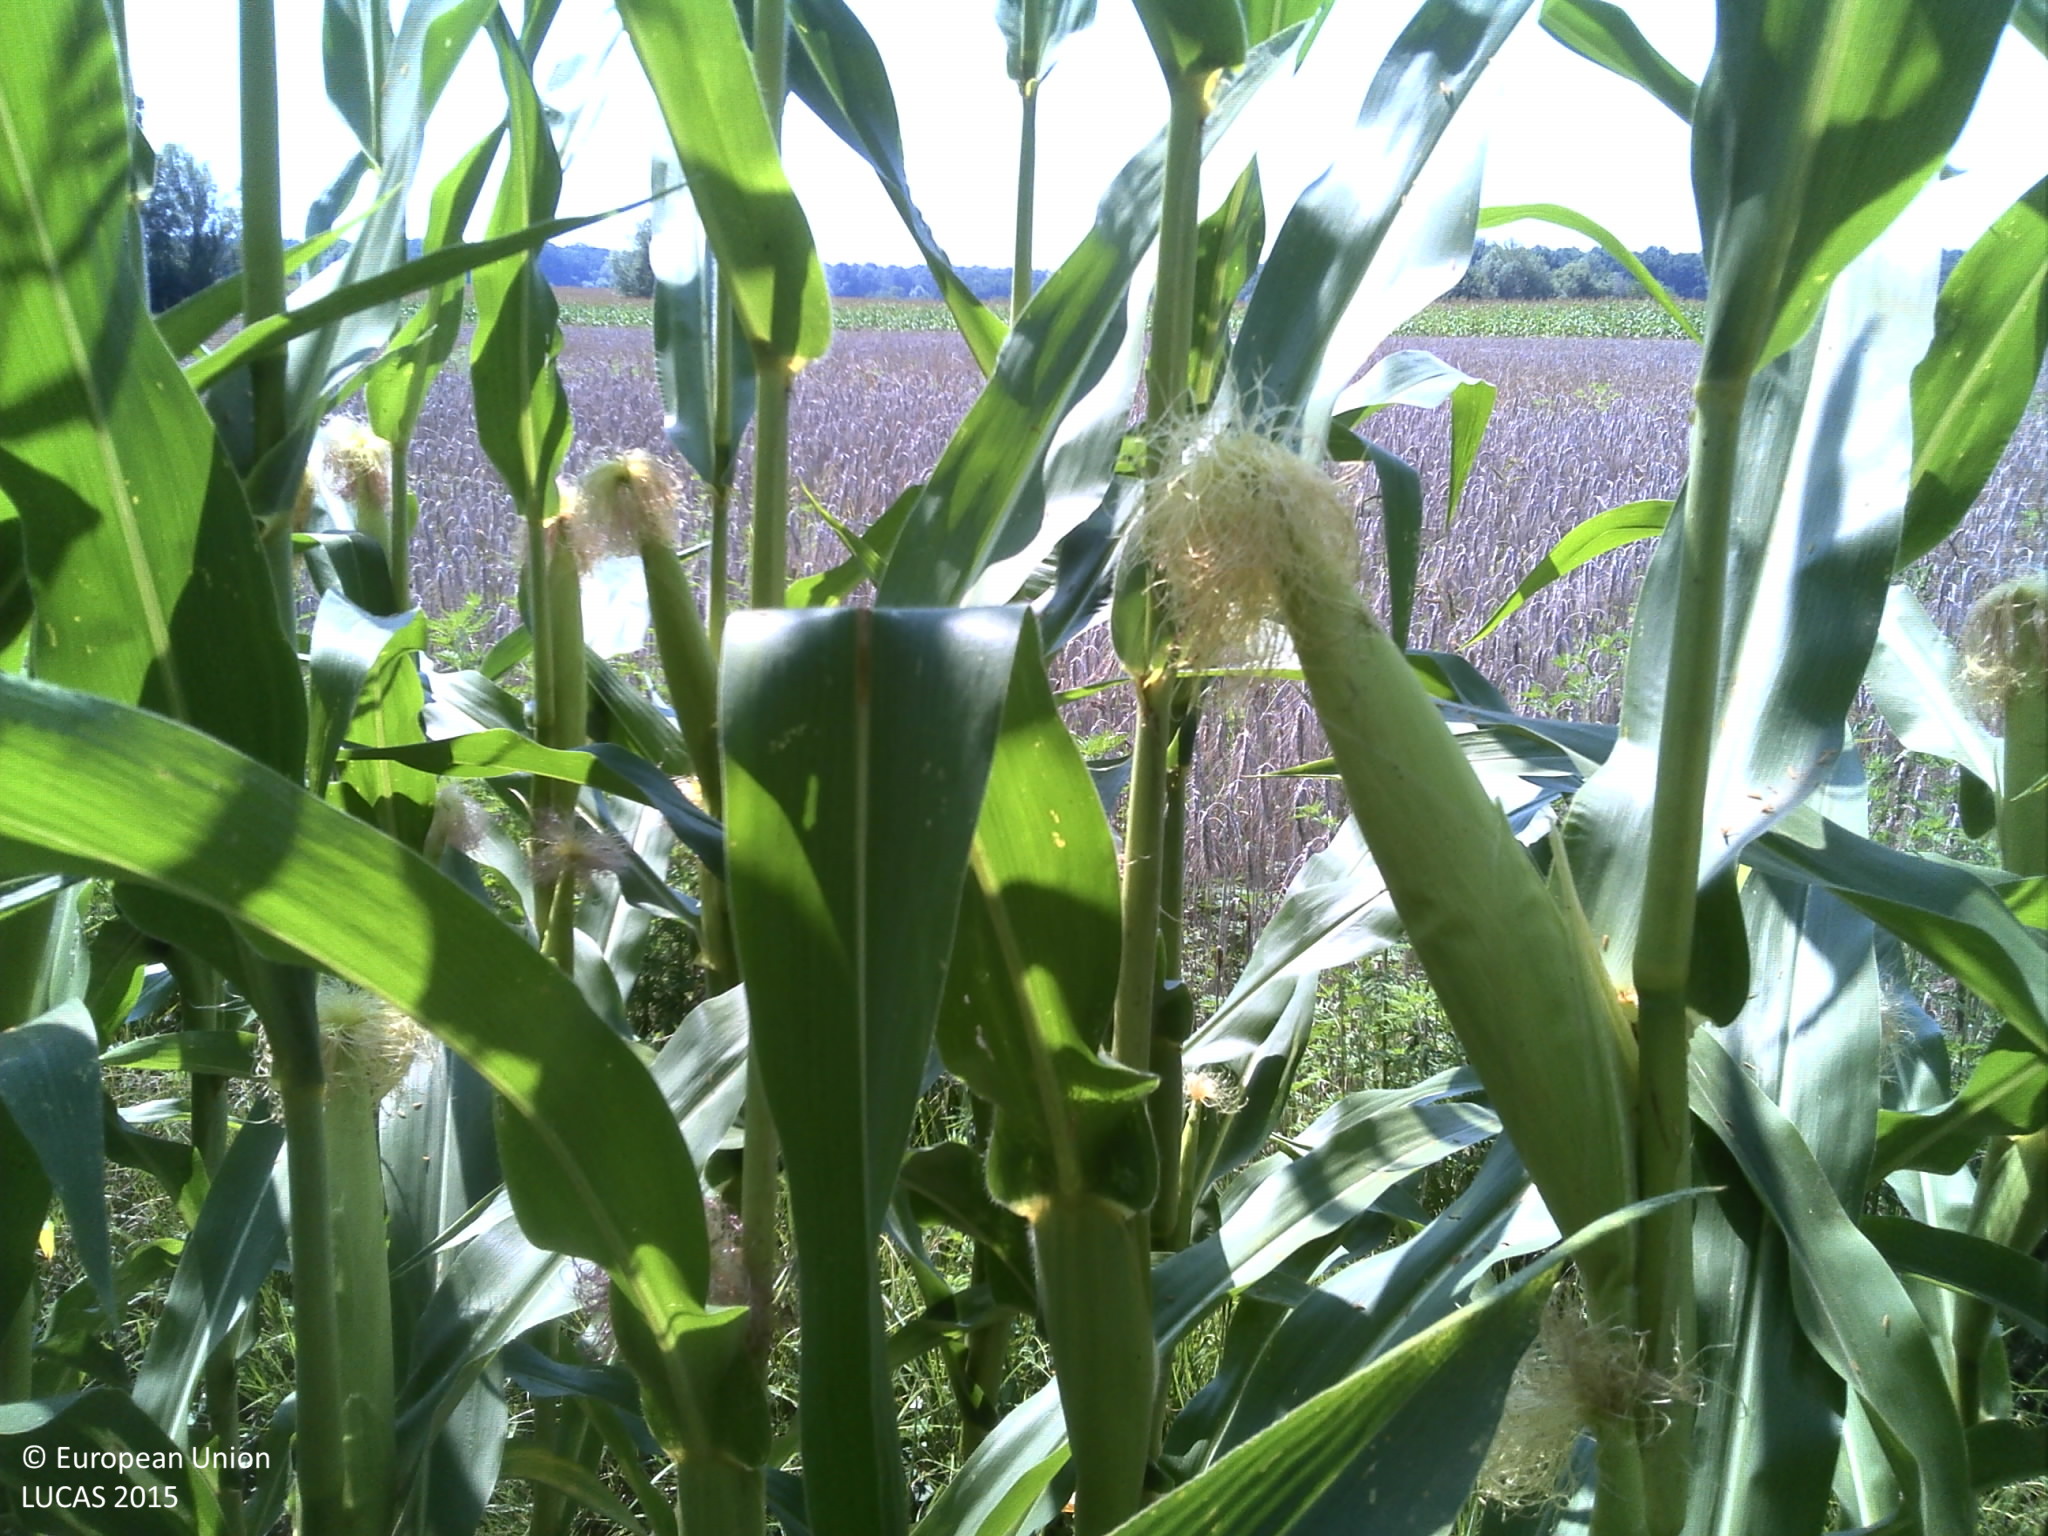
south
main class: Cropland
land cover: Maize
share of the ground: > 75 %
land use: Agriculture (excluding fallow land and kitchen gardens)
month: July
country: HR
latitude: 45.8660
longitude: 16.7628
